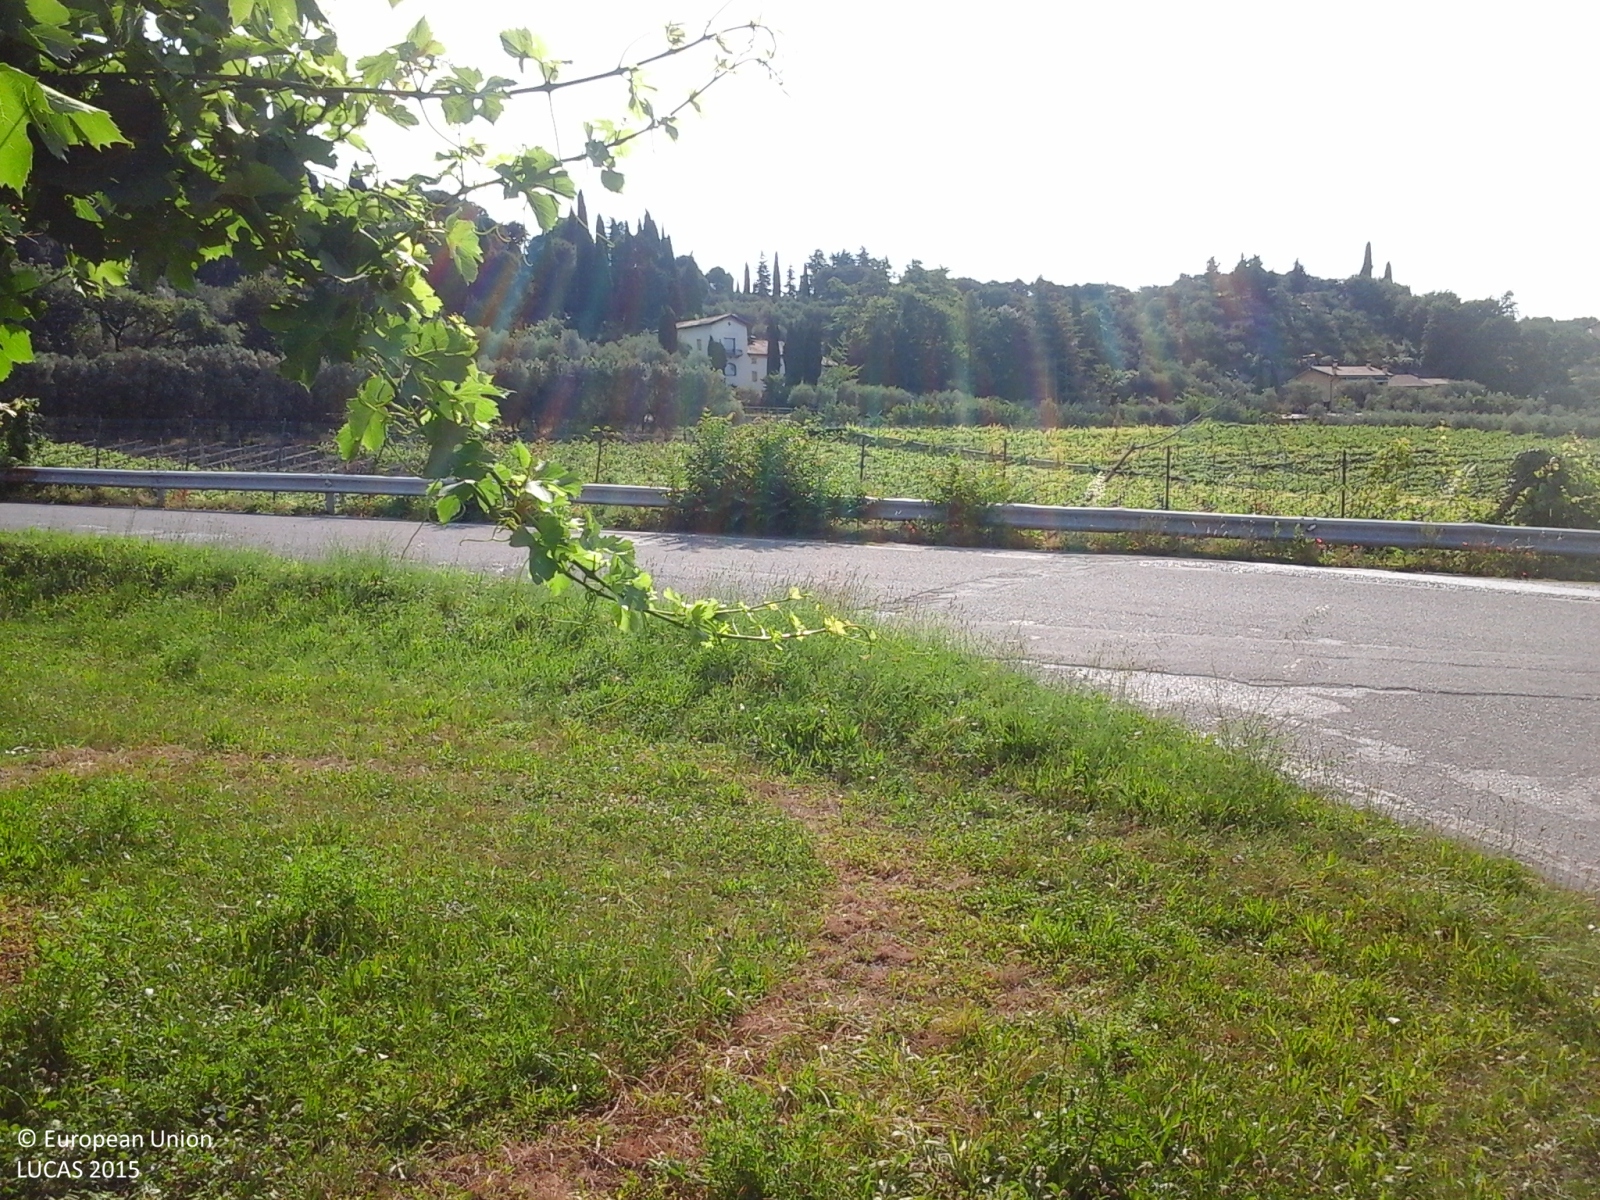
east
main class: Cropland
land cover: Vineyards
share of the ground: > 75 %
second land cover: Grassland without tree/shrub cover
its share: > 75 %
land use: Agriculture (excluding fallow land and kitchen gardens)
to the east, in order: Vineyards; Grassland without tree/shrub cover; Grass margins; Paved roads, cycling and walking lanes; Grass margins; Fences; Managed hedges; Grassland without tree/shrub cover; Vineyards; Grassland without tree/shrub cover; Vineyards; Grassland without tree/shrub cover; Fences; Olive groves; Artificial constructions in urban areas; Olive groves
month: June
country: IT
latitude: 45.5378
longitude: 10.7543
